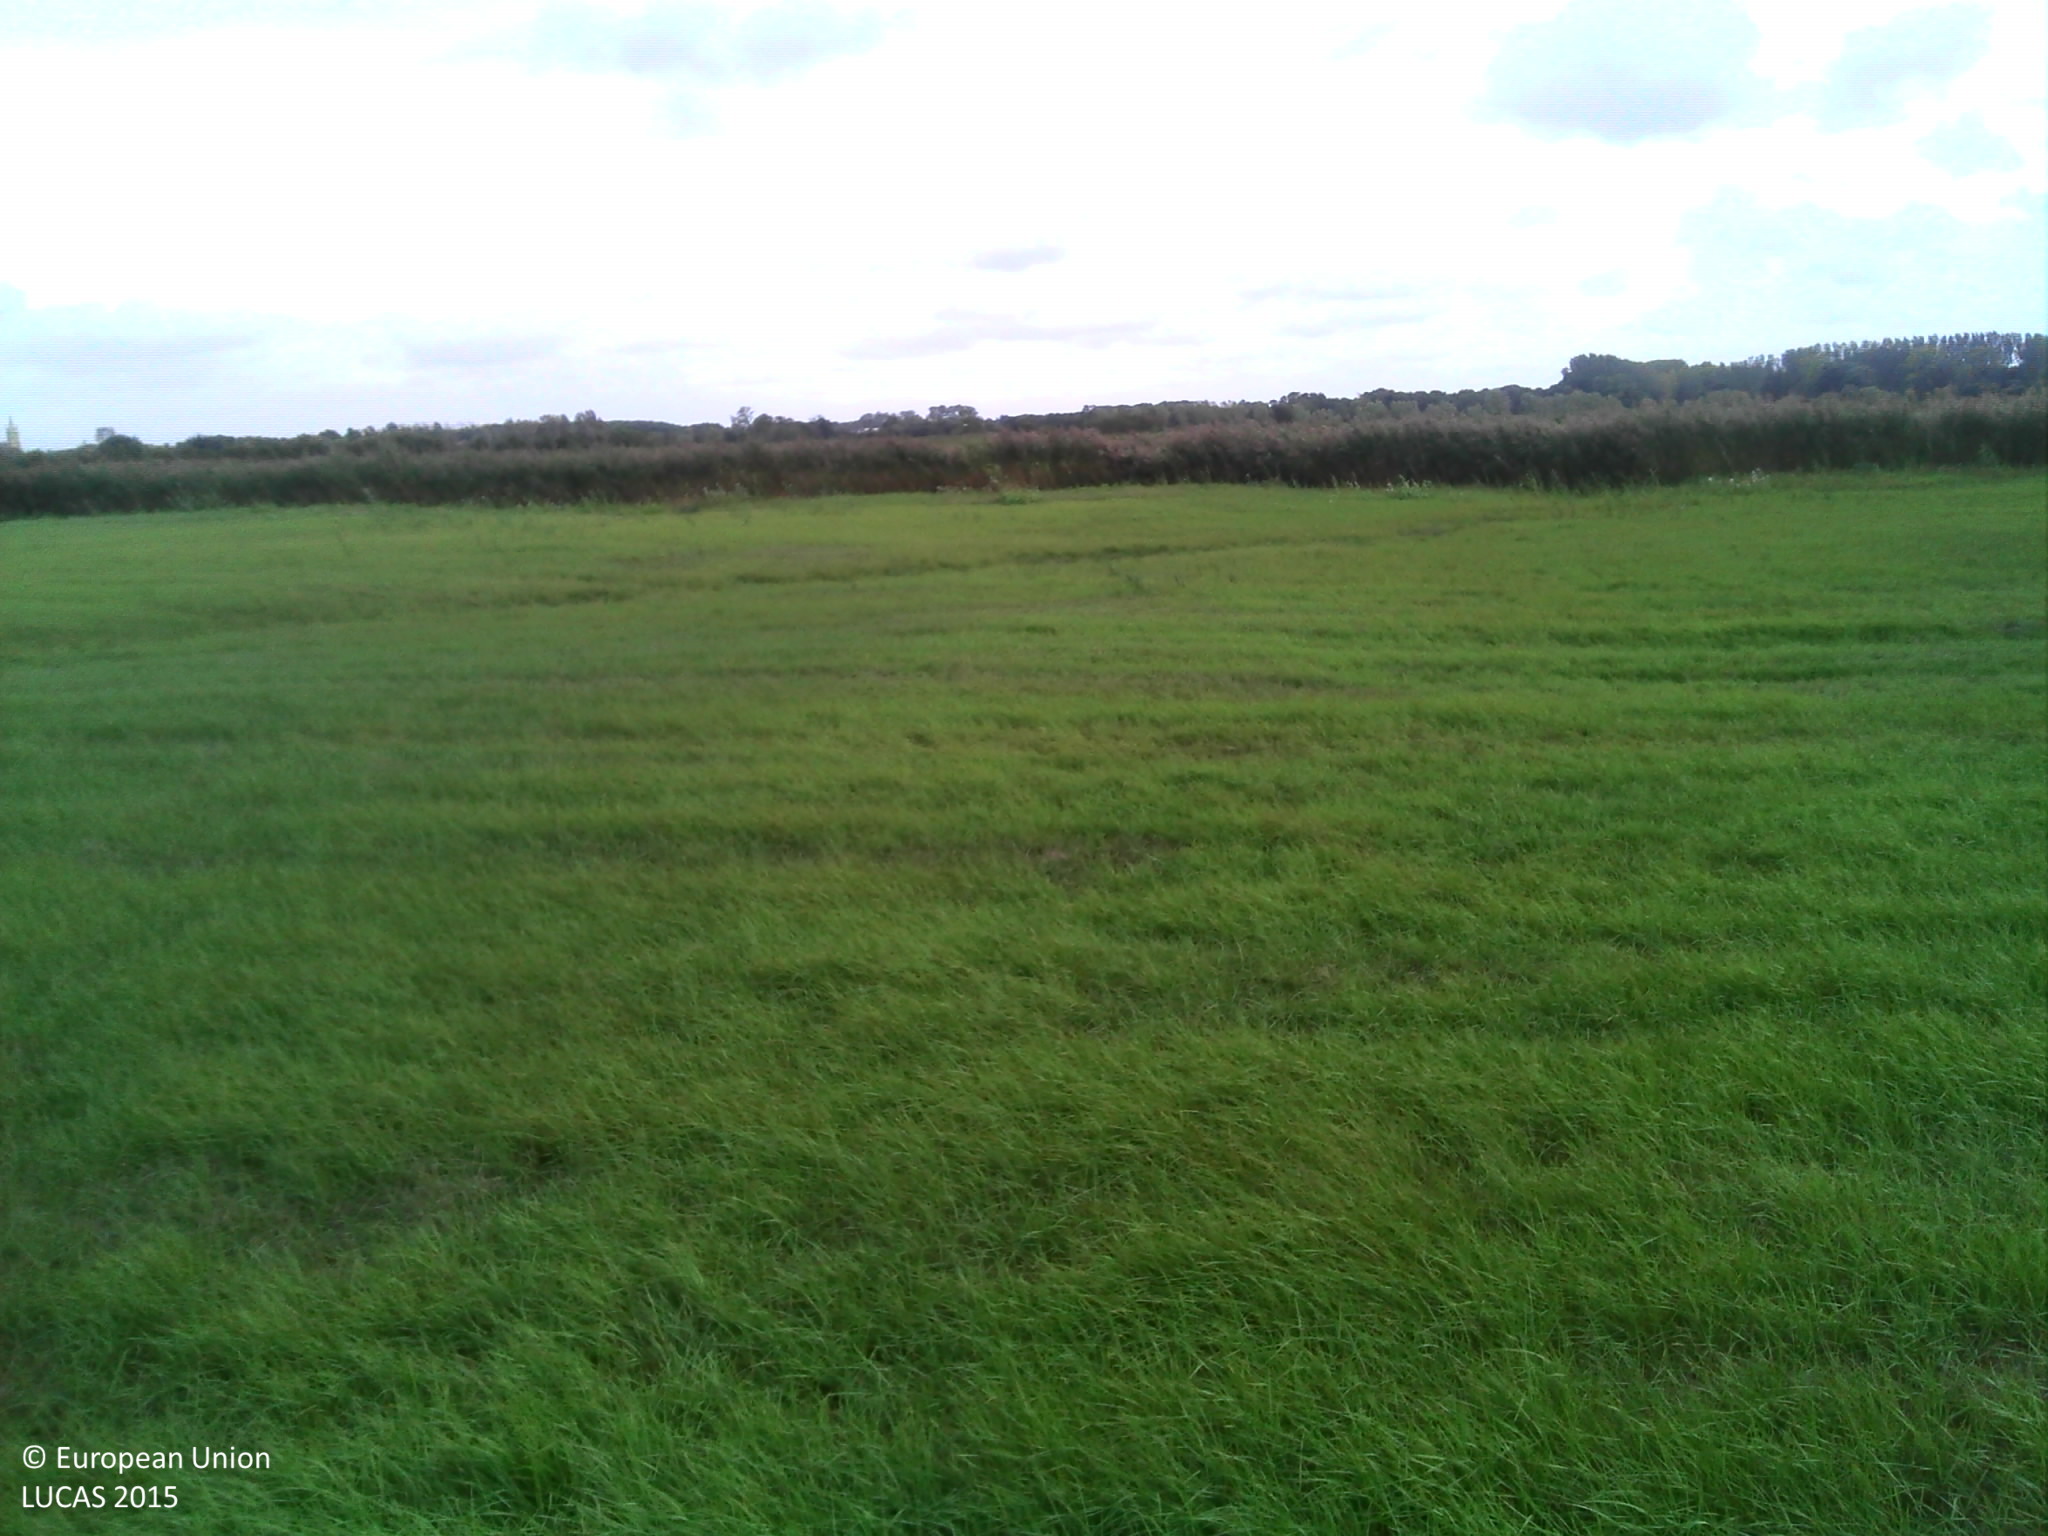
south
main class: Grassland
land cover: Grassland without tree/shrub cover
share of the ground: > 75 %
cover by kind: herbaceous plants 100 %
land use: Agriculture (excluding fallow land and kitchen gardens)
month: September
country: FR
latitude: 46.7557
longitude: -1.9188
